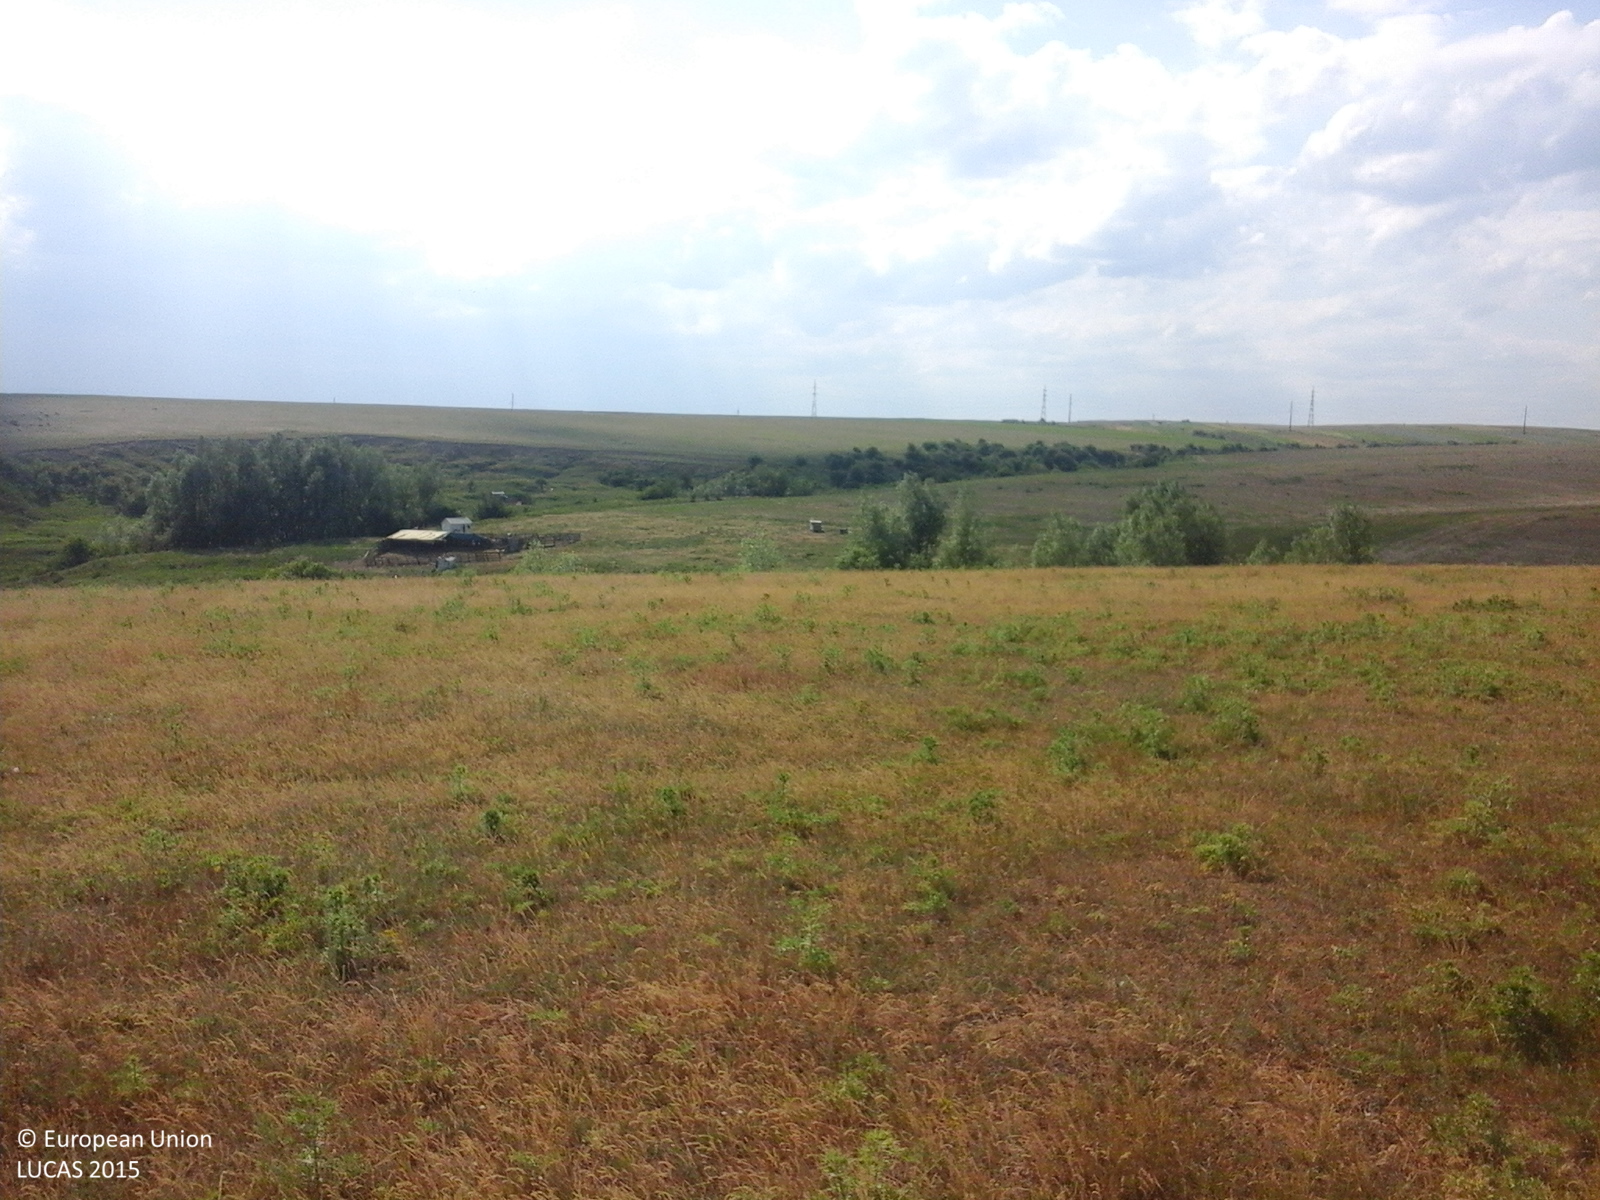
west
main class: Grassland
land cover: Grassland without tree/shrub cover
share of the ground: > 75 %
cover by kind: herbaceous plants 100 %
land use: Agriculture (excluding fallow land and kitchen gardens)
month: June
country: RO
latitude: 47.6754
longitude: 26.3216
